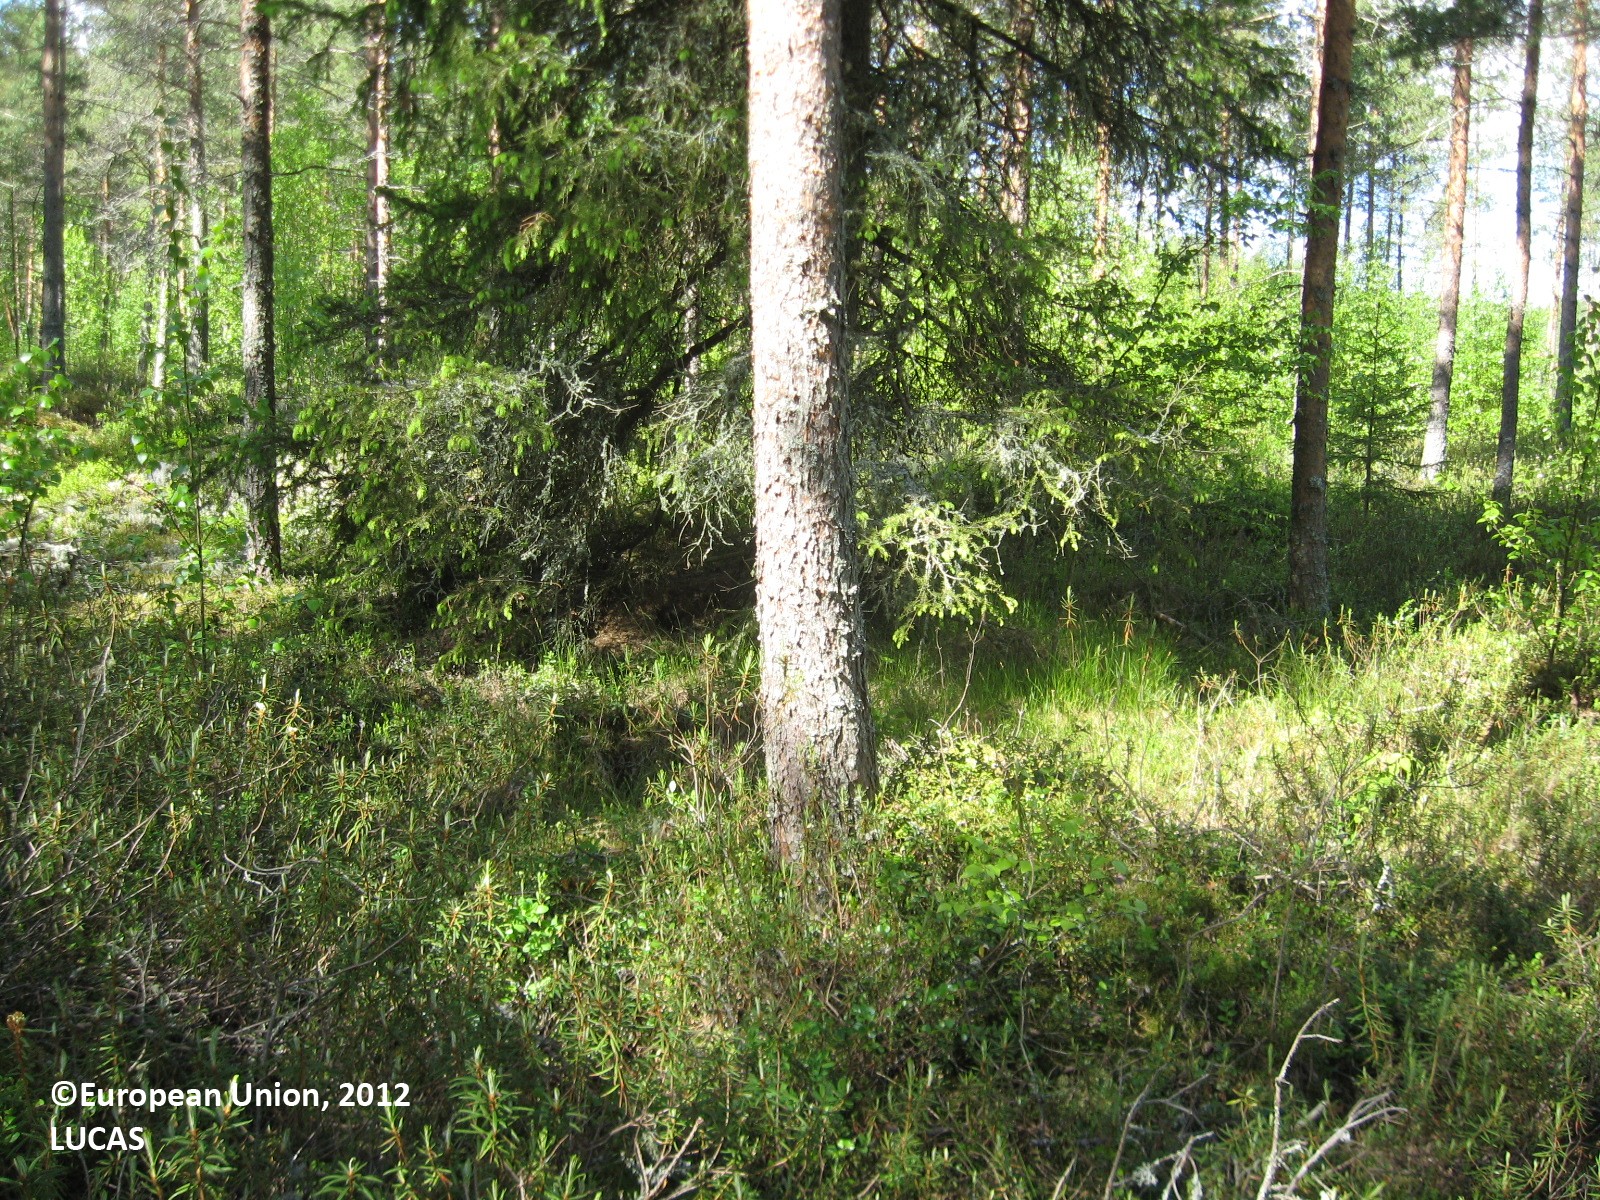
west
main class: Woodland
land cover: Pine dominated coniferous woodland
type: boreal forest
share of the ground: 50 - 75 %
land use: Forestry
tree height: > 5 m
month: June
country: FI
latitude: 63.2058
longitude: 22.7187
